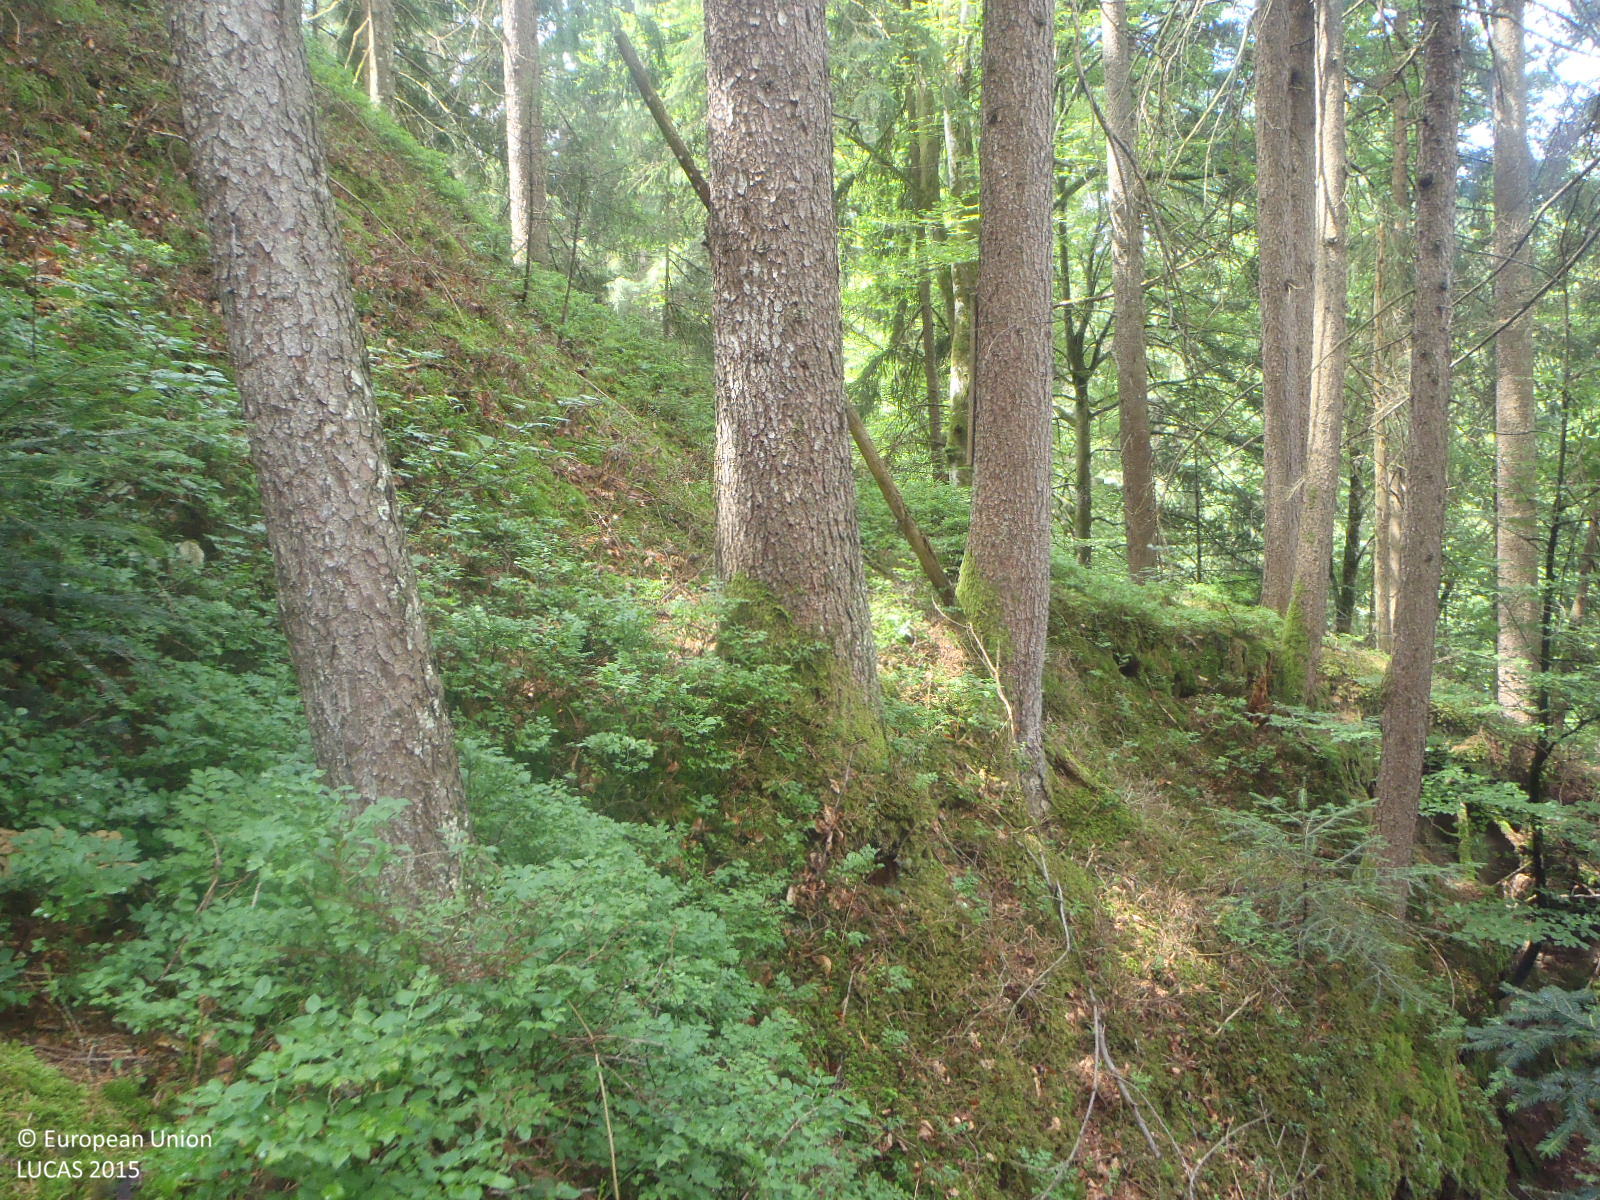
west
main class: Woodland
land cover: Spruce dominated mixed woodland
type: alpine coniferous forest
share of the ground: > 75 %
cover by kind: coniferous forest trees 60 %, broadleaved forest trees 25 %, shrubs 10 %, lichens and mosses 5 %
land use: Forestry
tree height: > 5 m
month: July
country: AT
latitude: 47.4092
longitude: 12.2115
